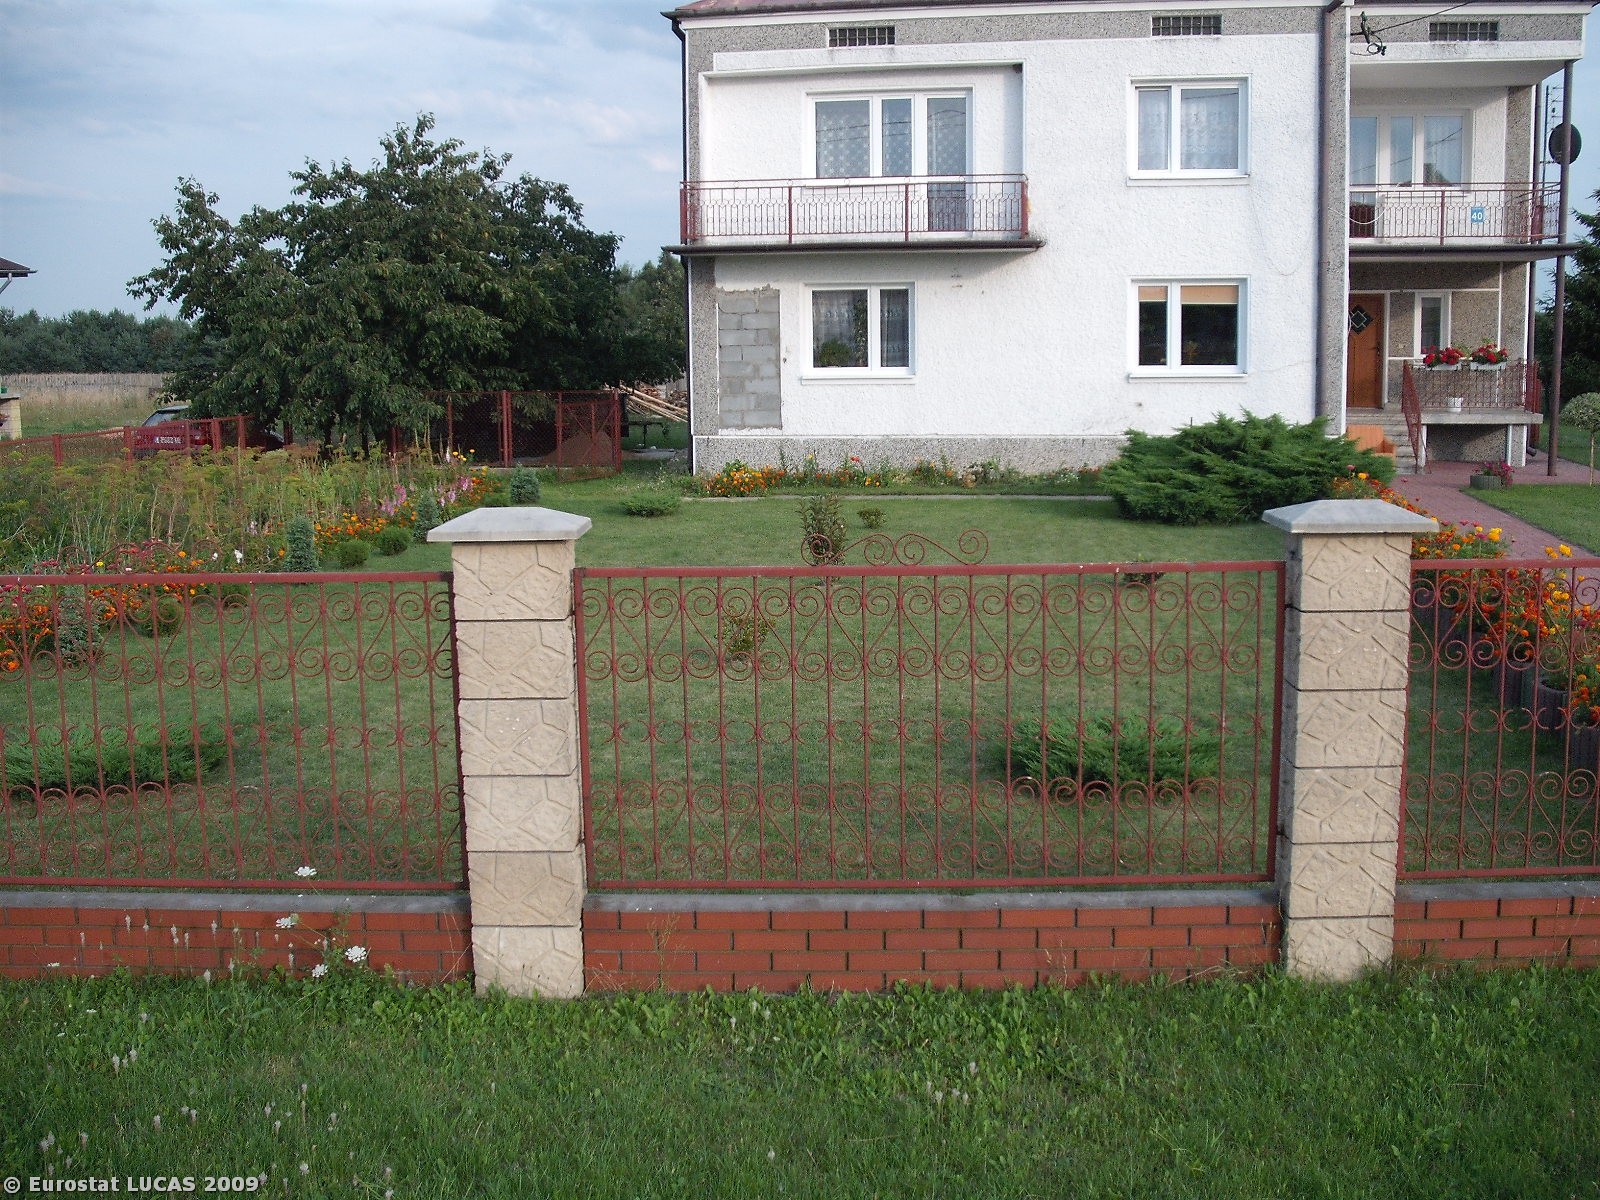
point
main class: Grassland
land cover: Grassland without tree/shrub cover
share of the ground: > 75 %
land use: Residential
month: July
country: PL
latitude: 50.6263
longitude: 21.2288
